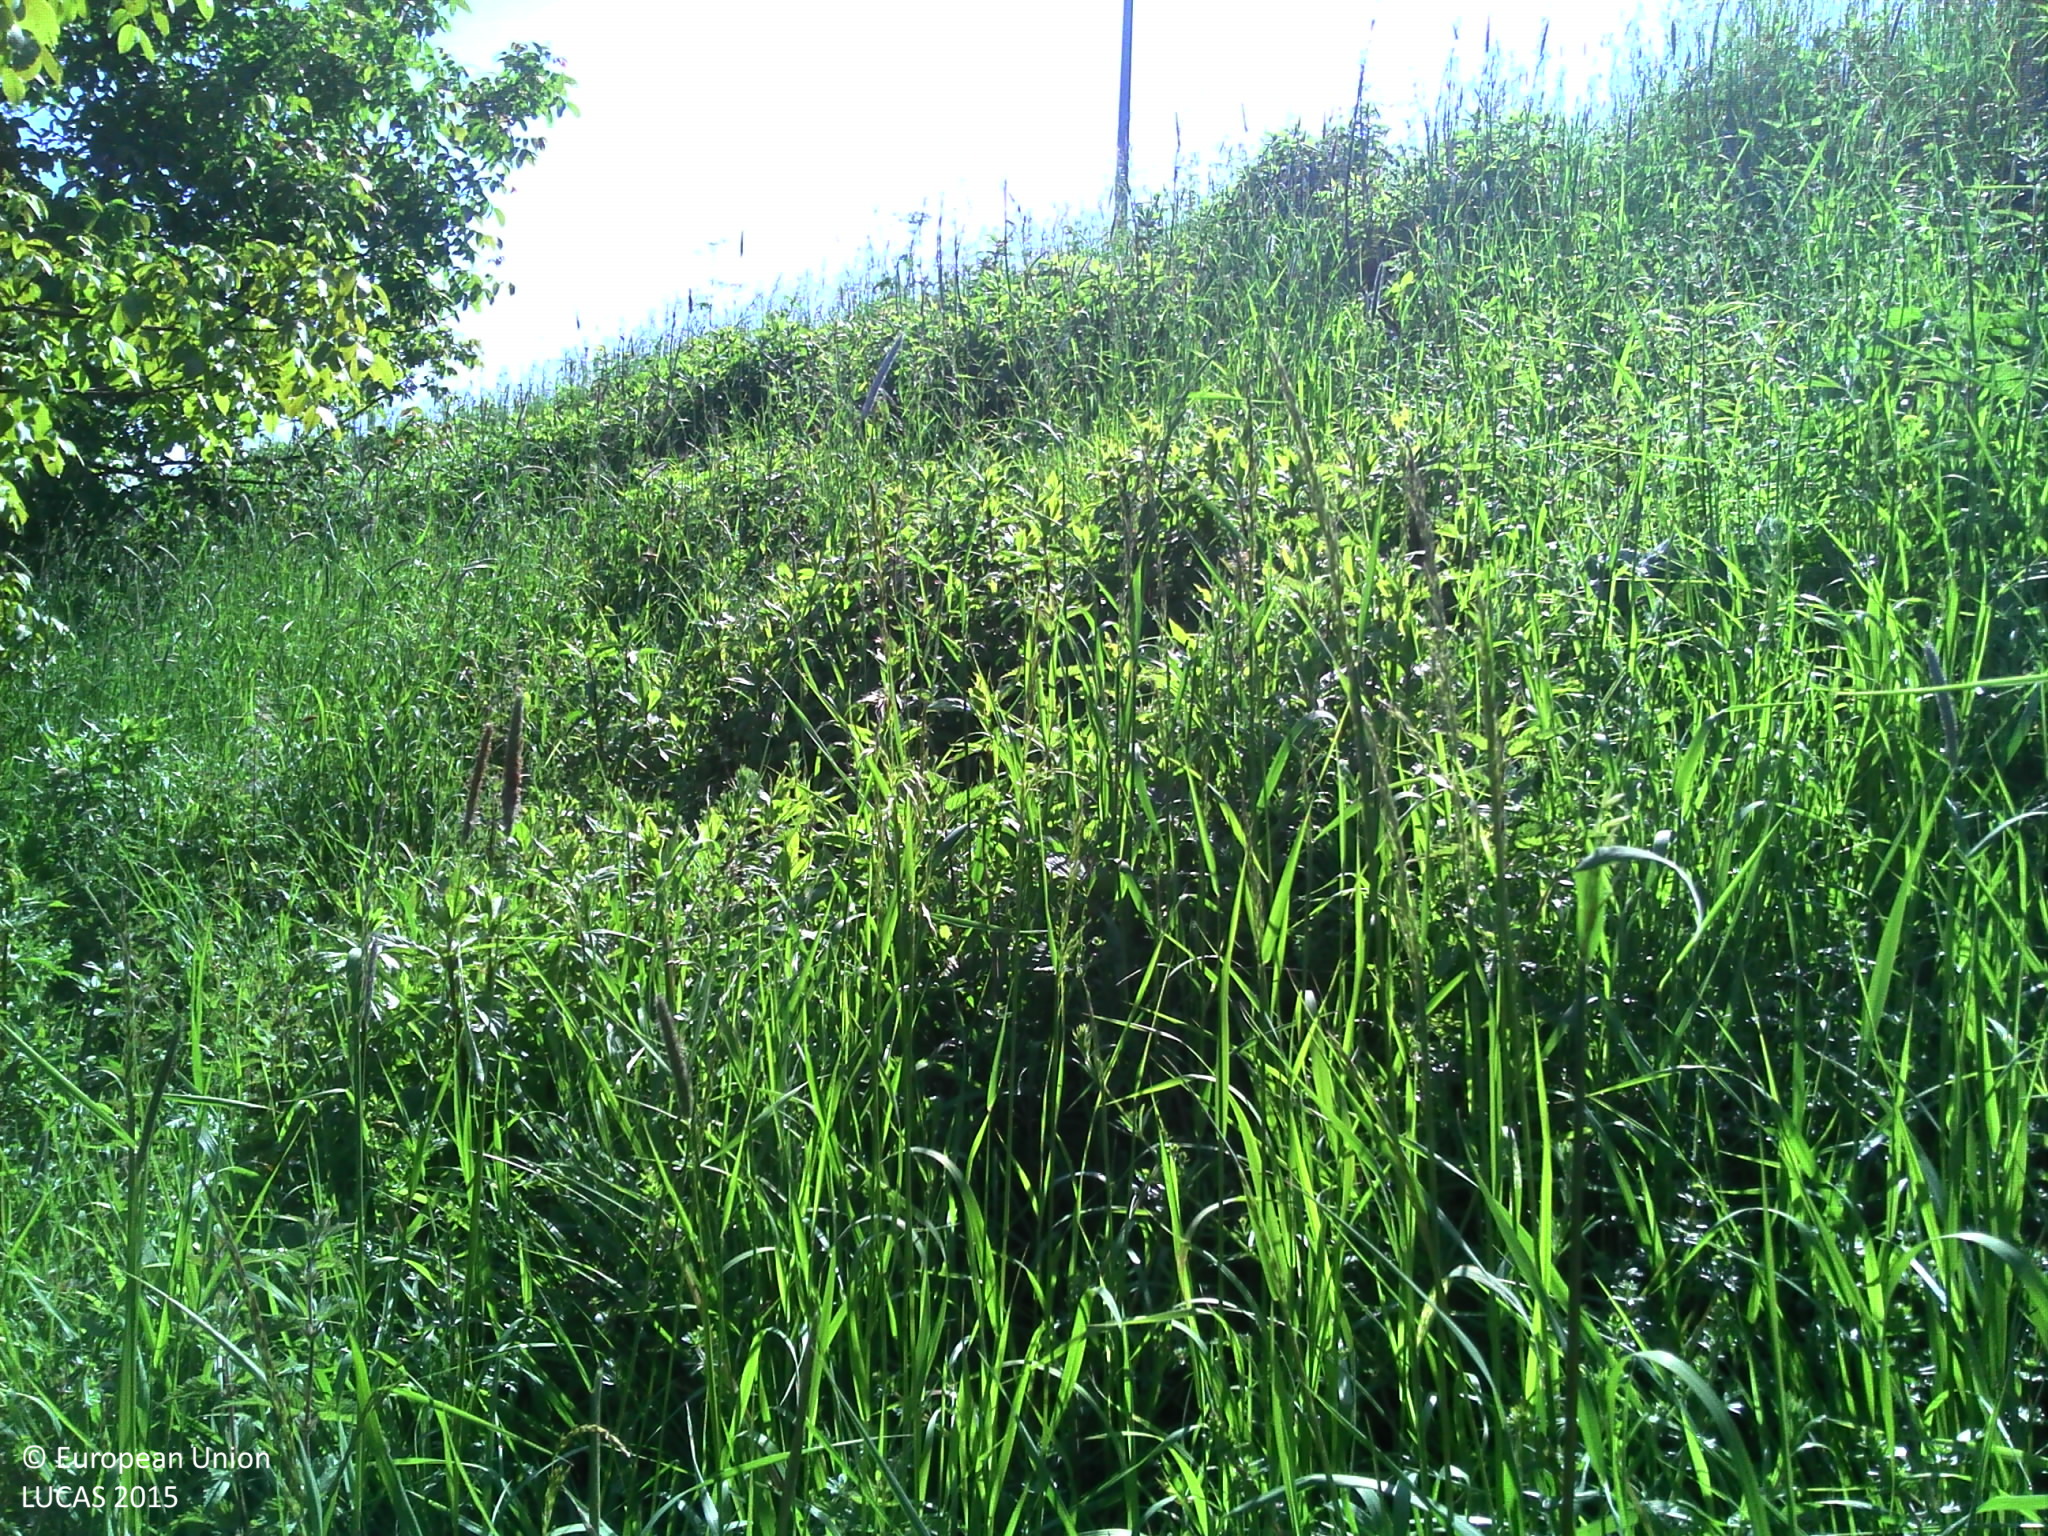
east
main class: Grassland
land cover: Spontaneously vegetated surfaces
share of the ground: > 75 %
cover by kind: herbaceous plants 100 %
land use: Semi-natural and natural areas not in use
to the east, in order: Spontaneously vegetated surfaces; Grass margins; Paved roads, cycling and walking lanes; Grass margins; Spontaneously vegetated surfaces; Fences; Grassland without tree/shrub cover; Fences; Grass margins; Grassland without tree/shrub cover; Abandoned hedges; Fences; Grassland without tree/shrub cover; Fences; Broadleaved woodland
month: June
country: BE
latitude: 50.5172
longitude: 5.6970
